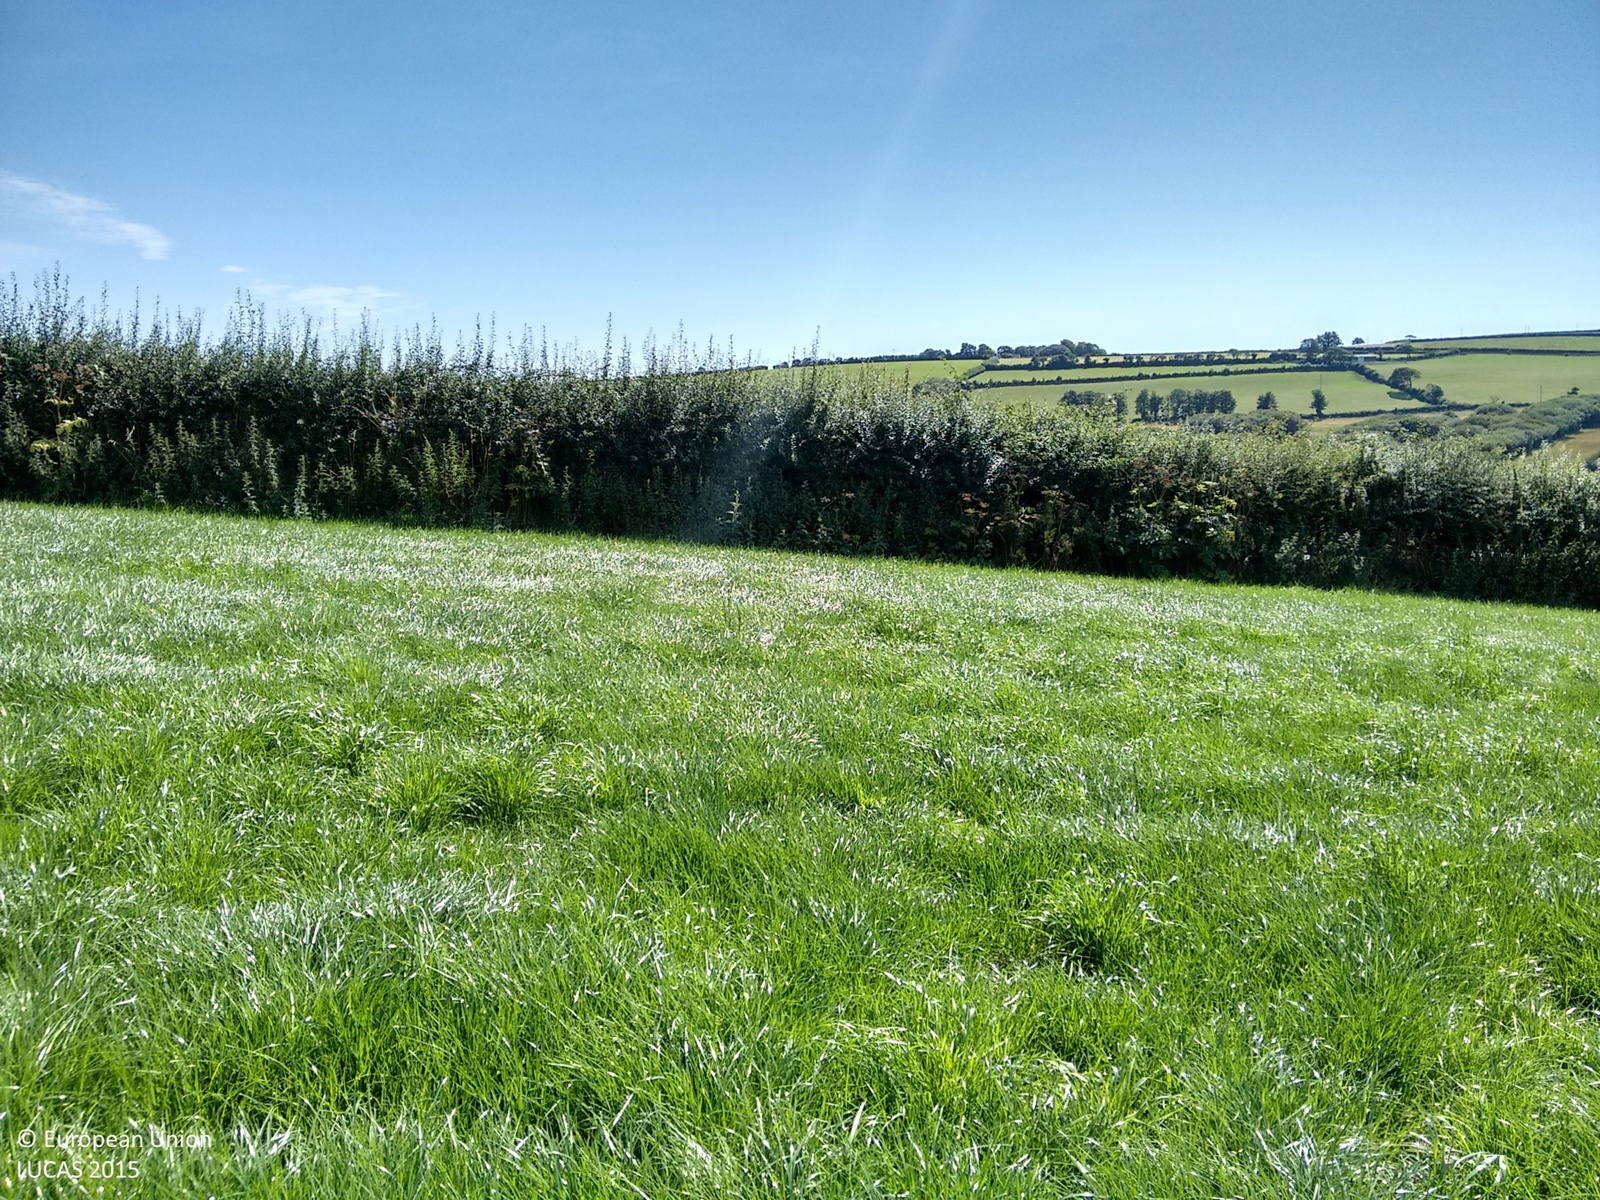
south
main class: Grassland
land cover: Grassland without tree/shrub cover
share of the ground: > 75 %
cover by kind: herbaceous plants 100 %
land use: Agriculture (excluding fallow land and kitchen gardens)
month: August
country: GB
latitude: 51.7947
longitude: -4.4738
